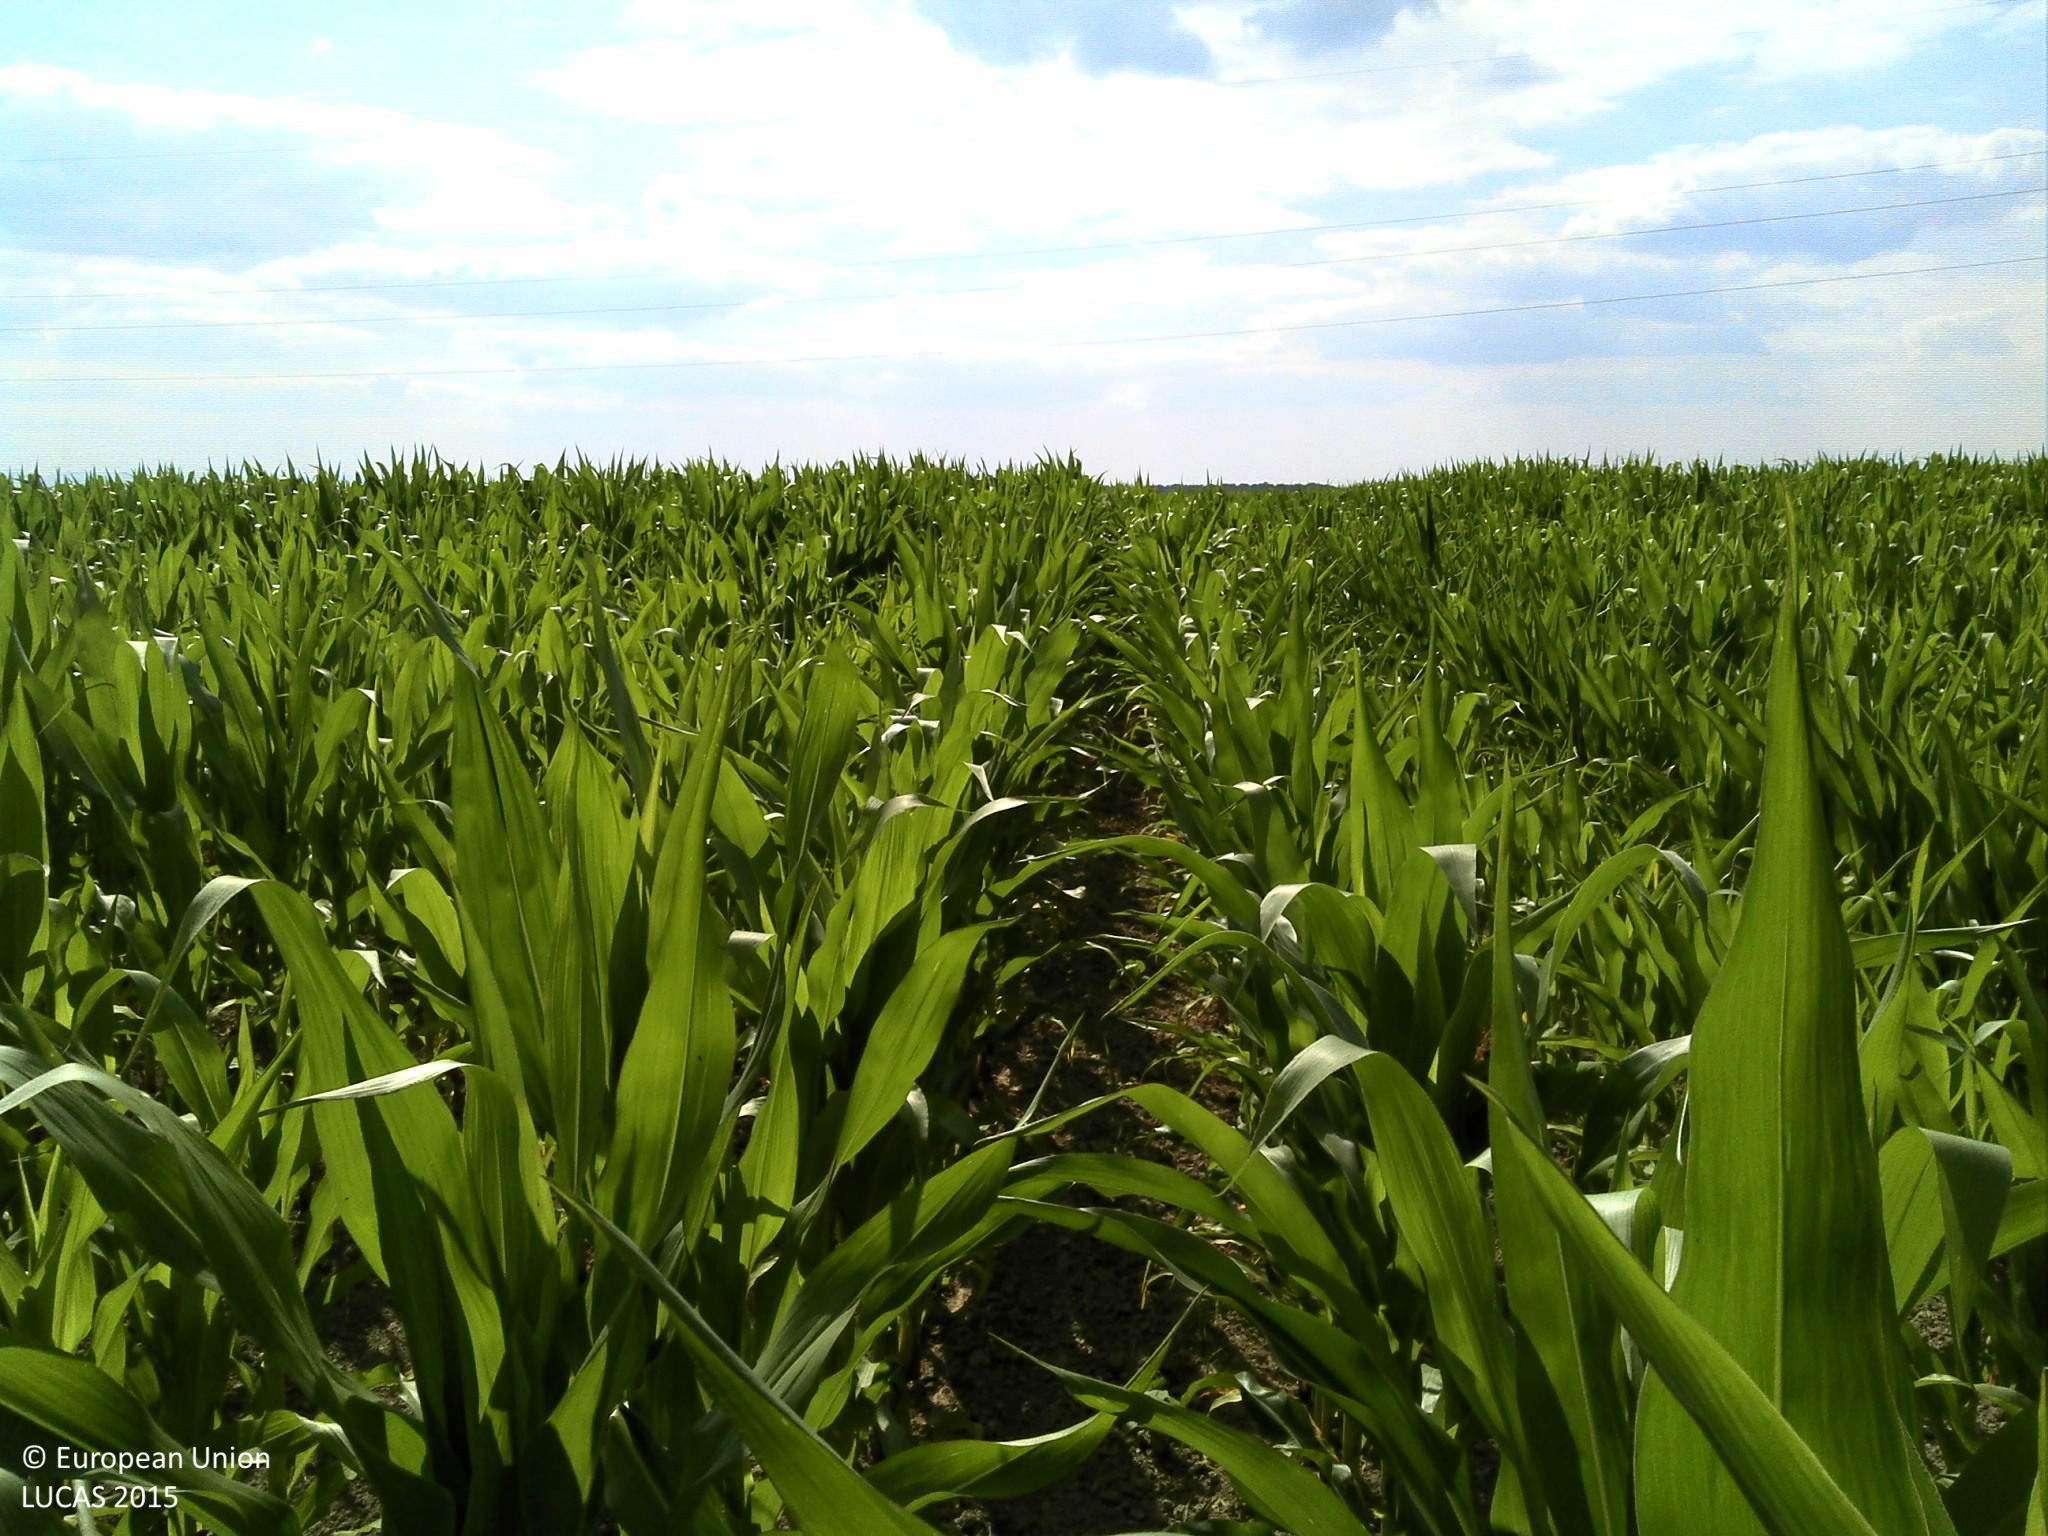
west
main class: Cropland
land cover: Maize
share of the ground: 50 - 75 %
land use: Agriculture (excluding fallow land and kitchen gardens)
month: June
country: HR
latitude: 45.6753
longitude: 18.1829
